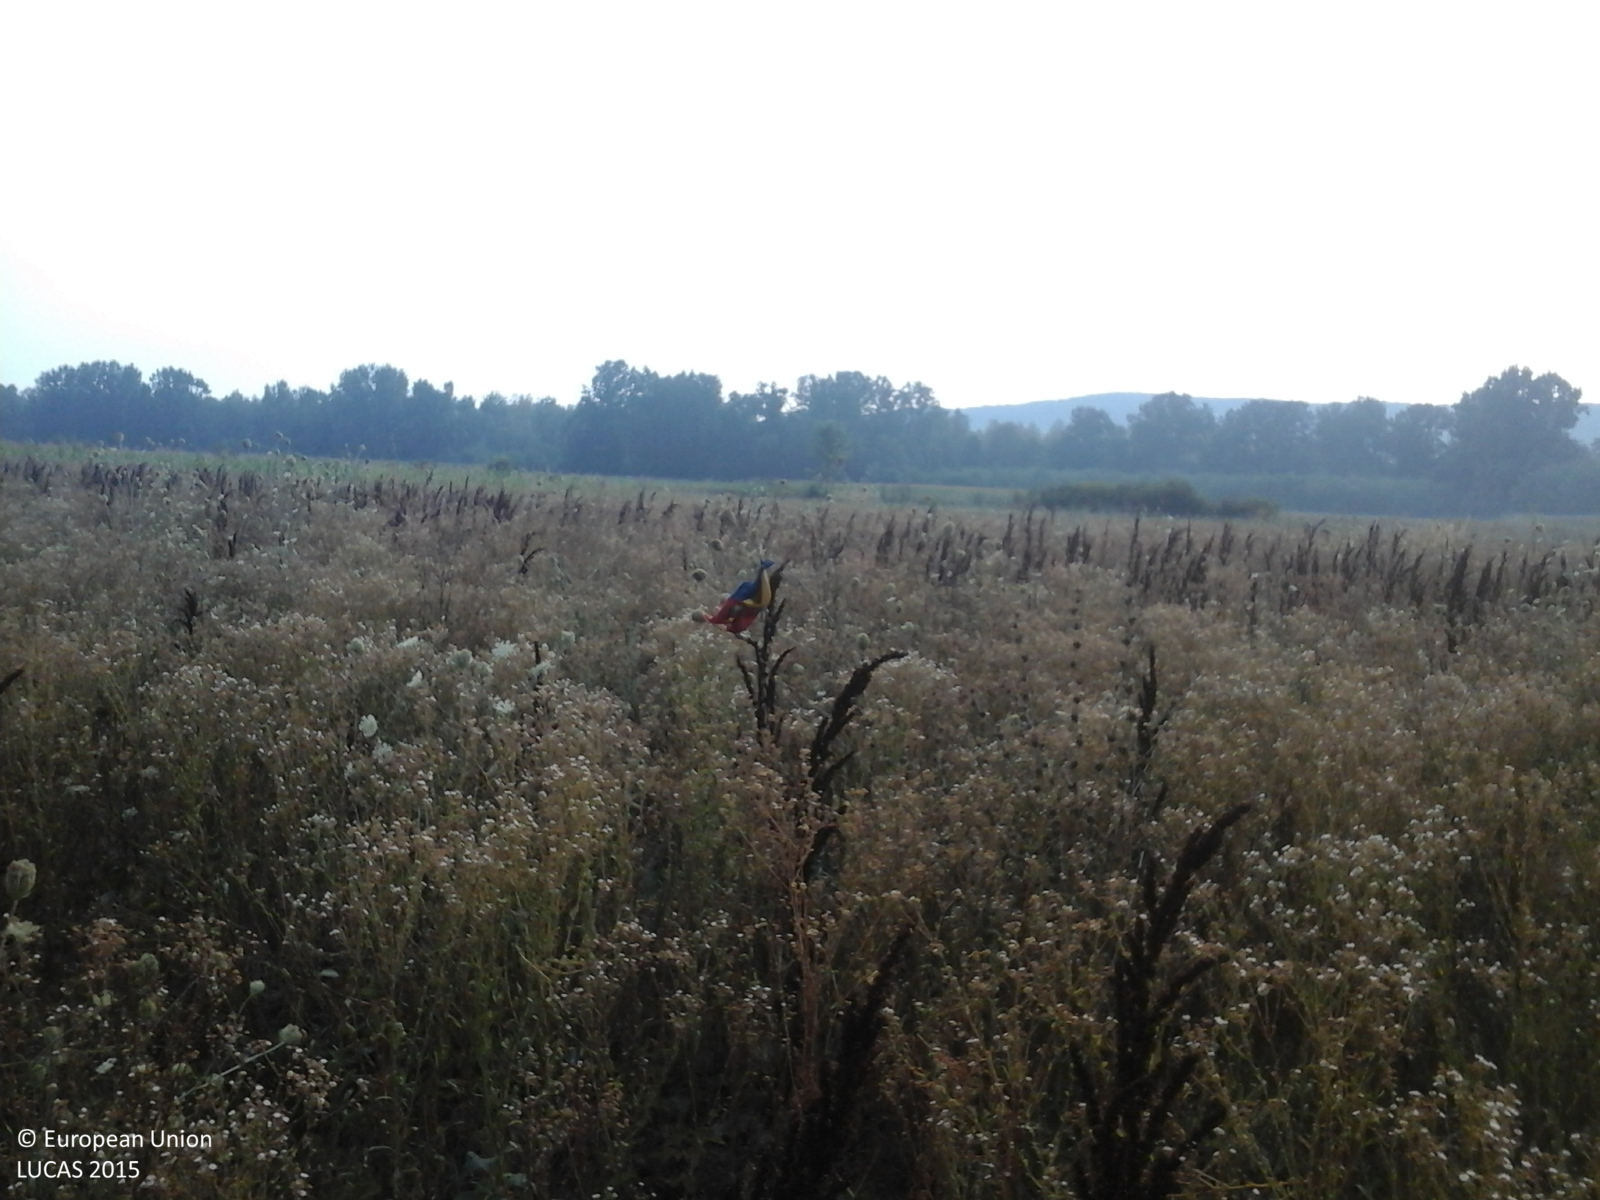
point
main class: Grassland
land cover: Spontaneously vegetated surfaces
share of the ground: > 75 %
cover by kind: herbaceous plants 100 %
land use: Fallow land
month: August
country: RO
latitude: 44.6674
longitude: 23.5131
